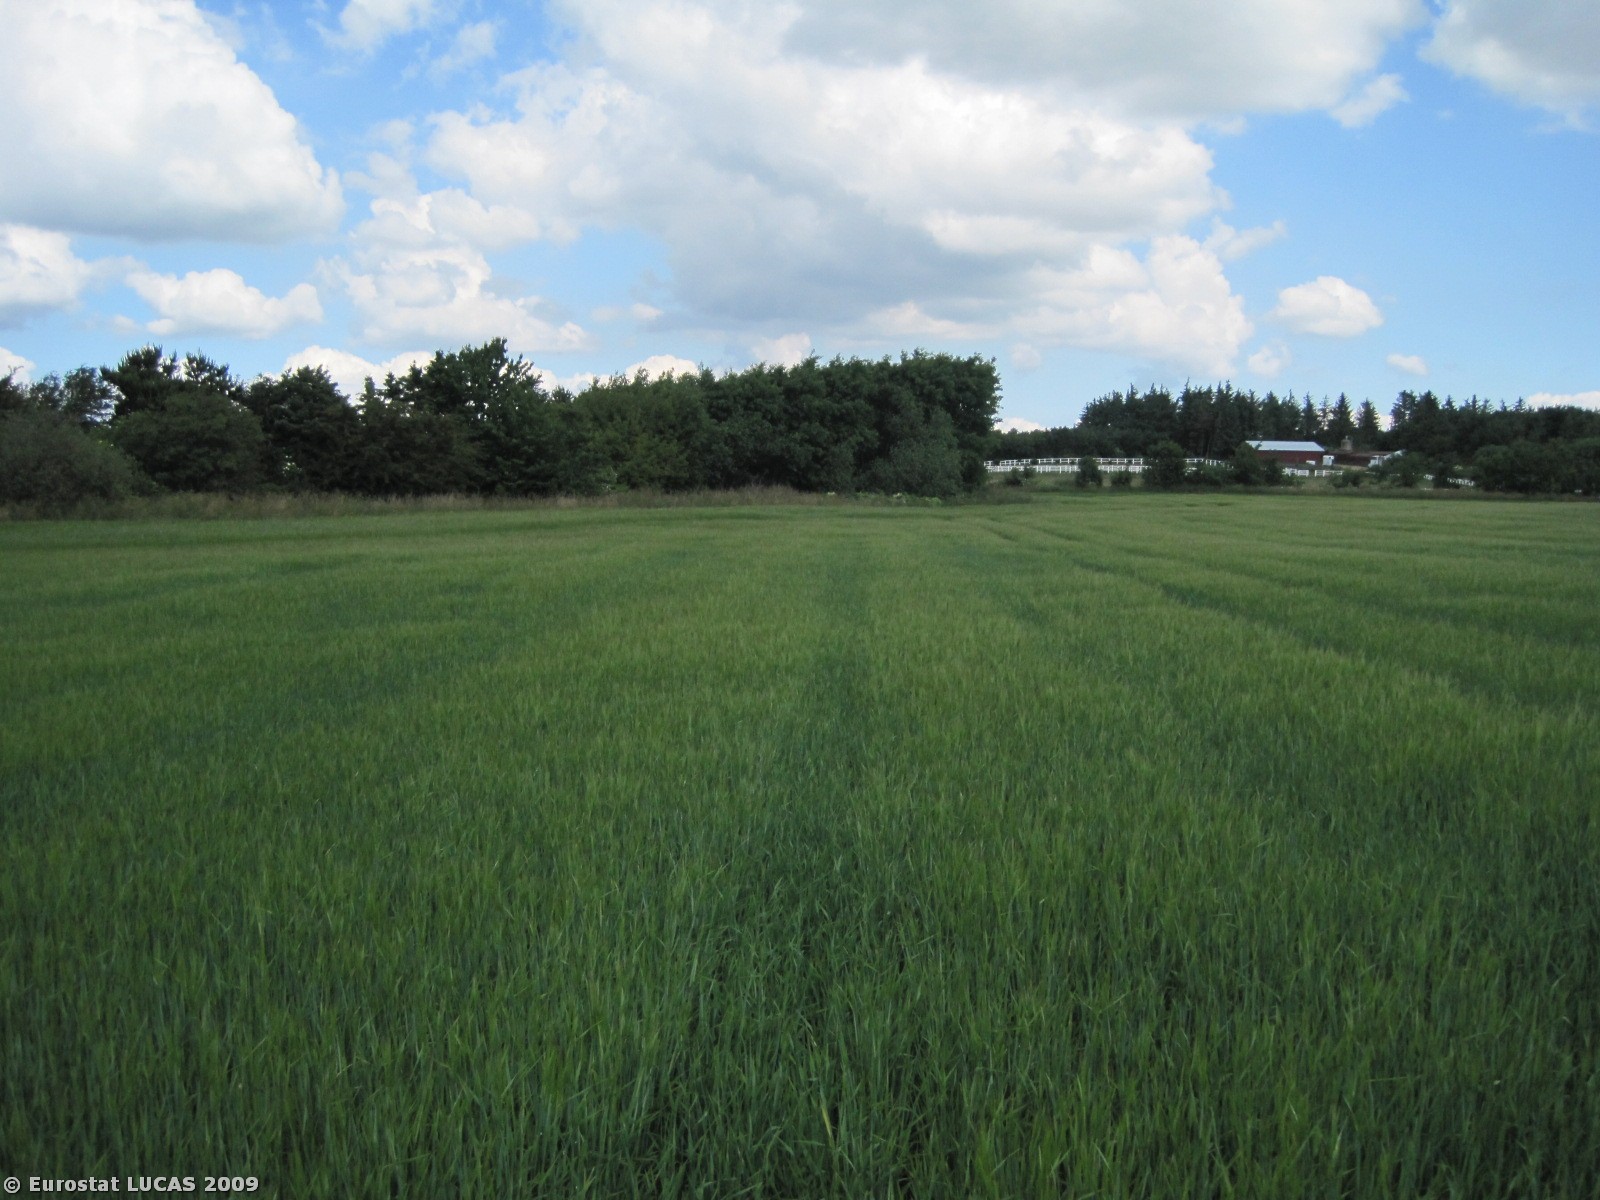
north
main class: Cropland
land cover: Barley
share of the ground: > 75 %
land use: Agriculture (excluding fallow land and kitchen gardens)
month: June
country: DK
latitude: 56.6511
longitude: 8.9738
